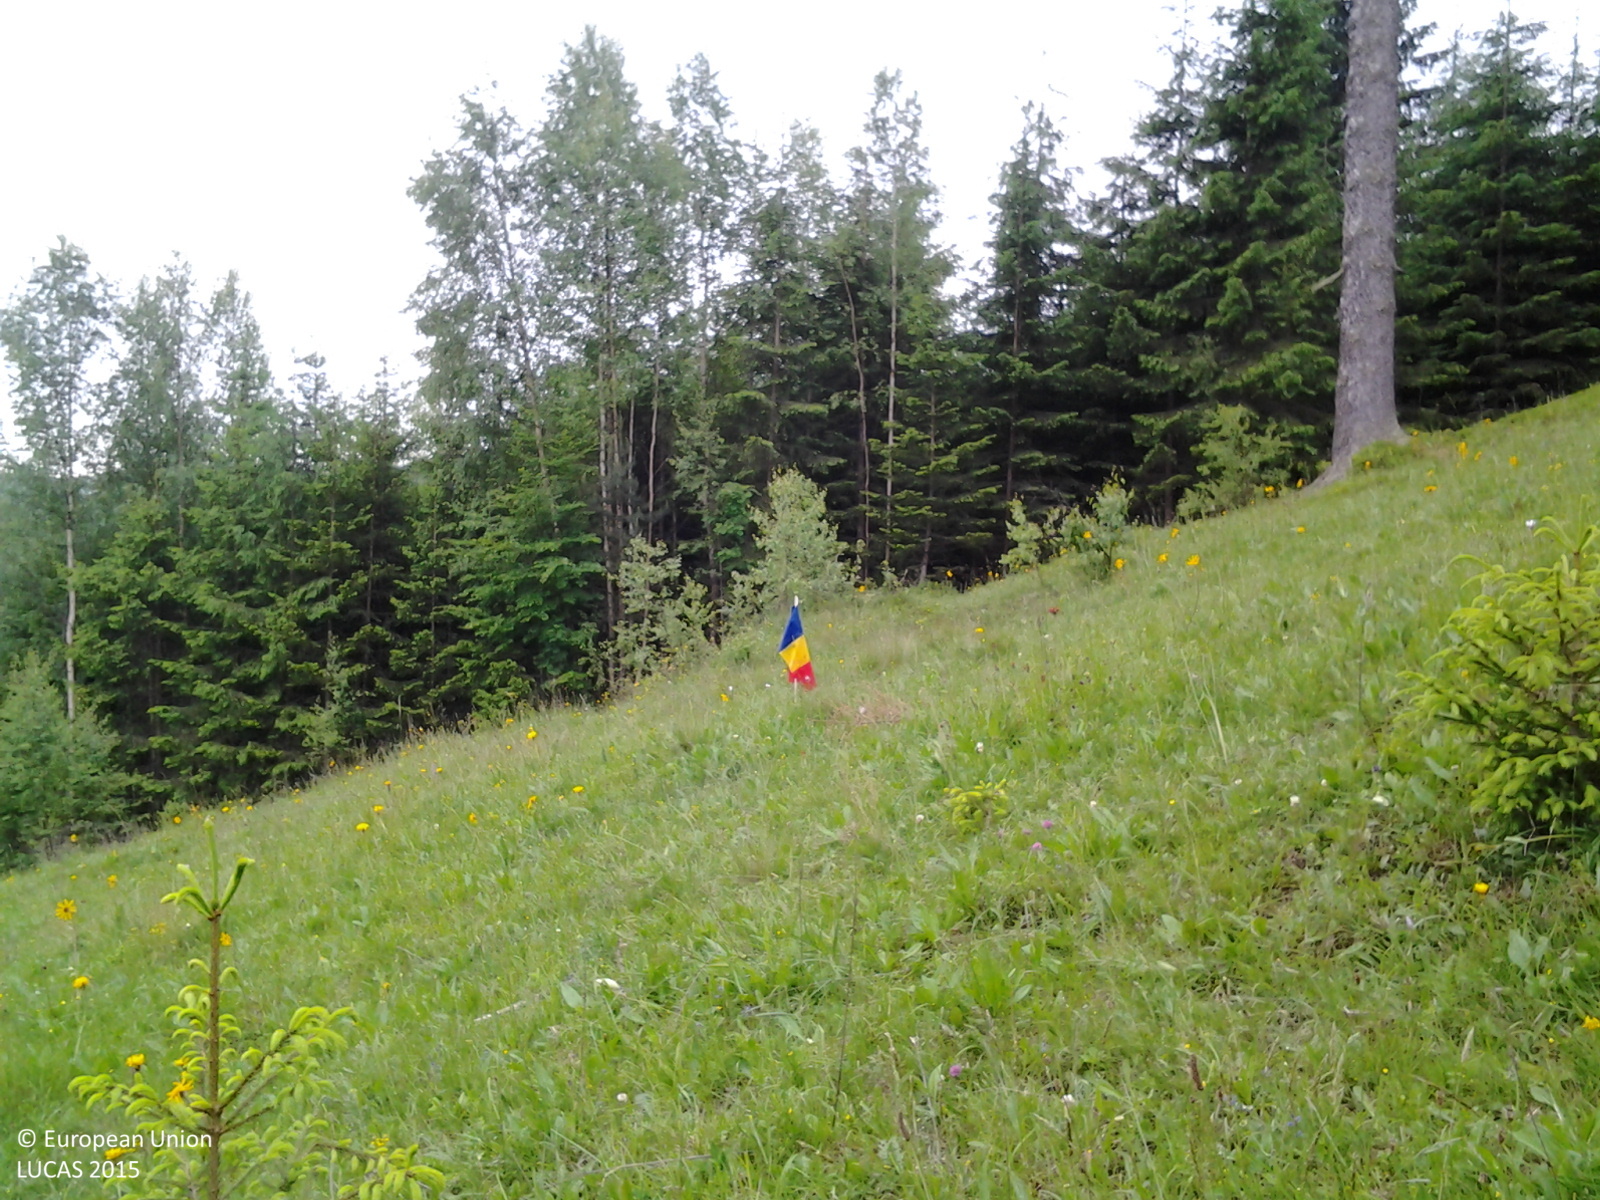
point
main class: Grassland
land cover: Grassland with sparse tree/shrub cover
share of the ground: > 75 %
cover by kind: herbaceous plants 85 %, shrubs 10 %, coniferous forest trees 5 %
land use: Agriculture (excluding fallow land and kitchen gardens)
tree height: > 5 m
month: June
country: RO
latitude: 47.7553
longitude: 25.1433
